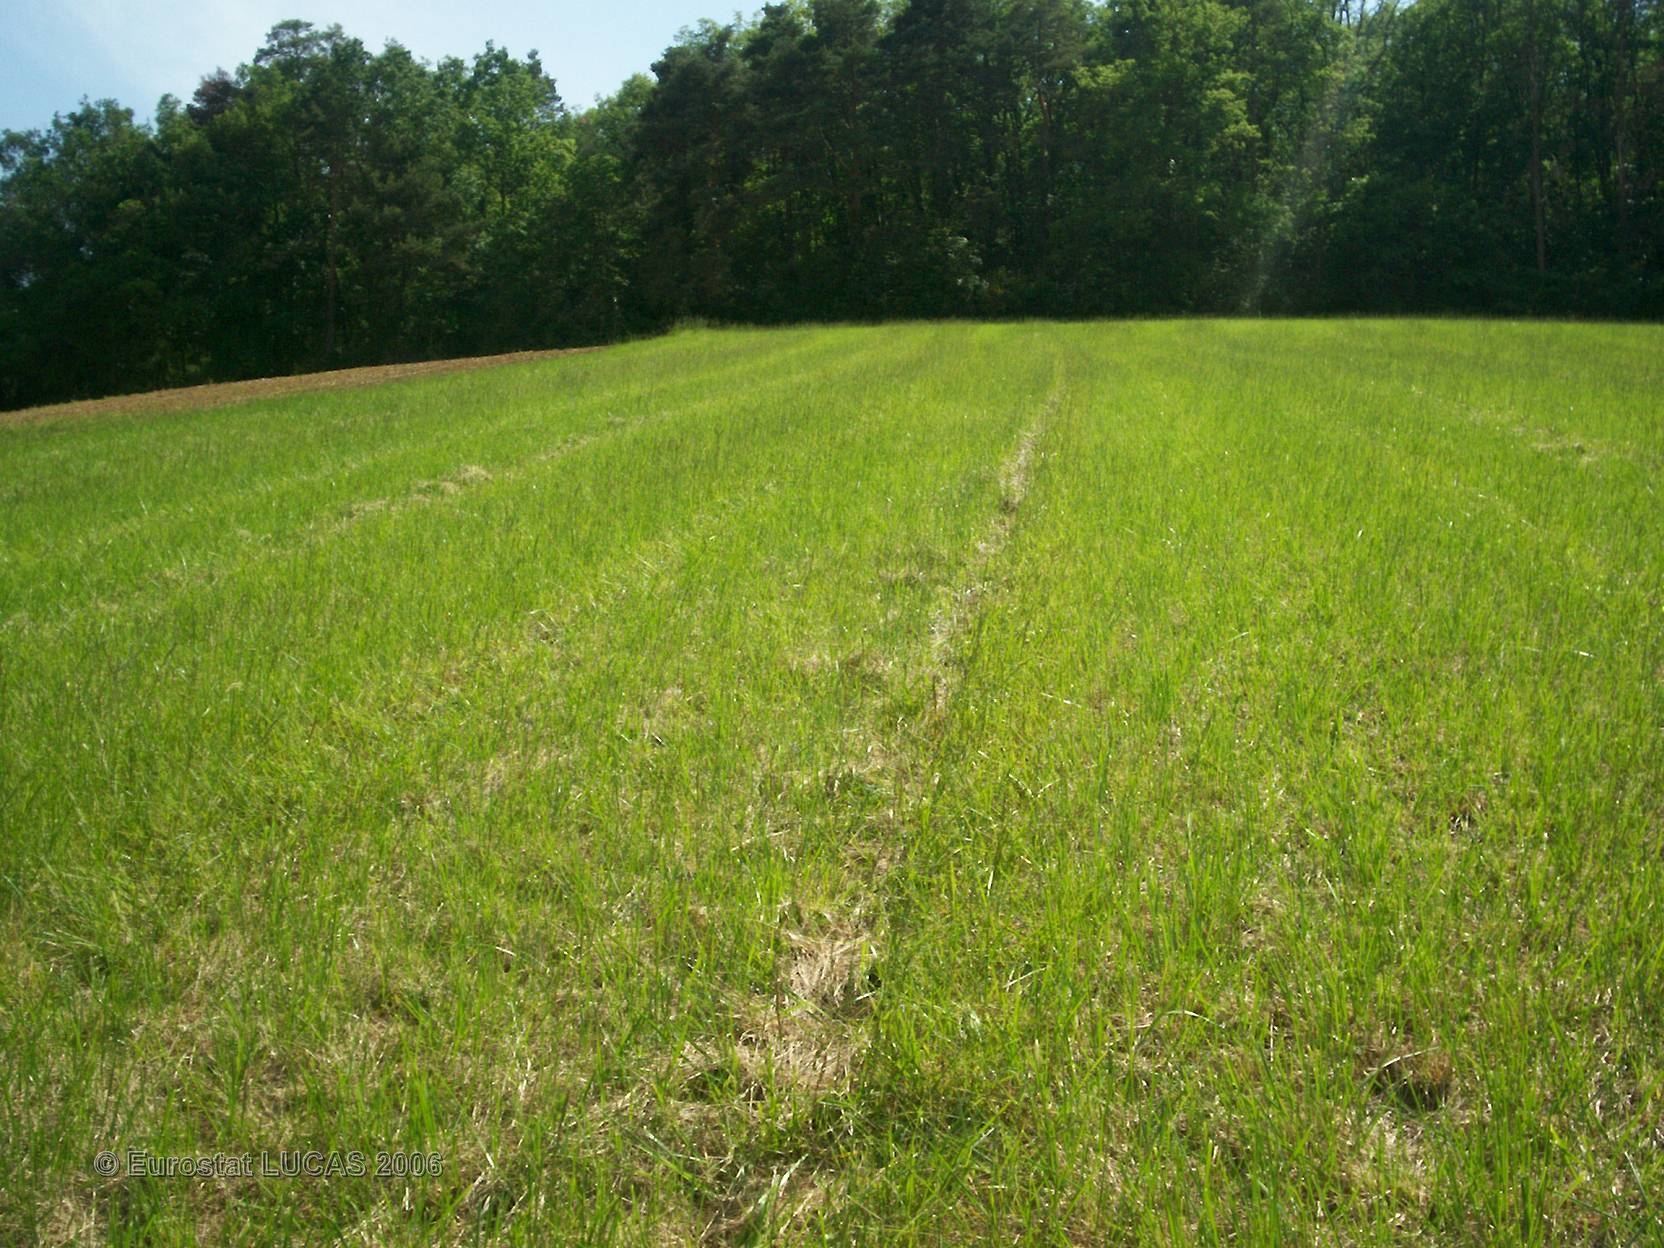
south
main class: Grassland
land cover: Grassland without tree/shrub cover
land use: Agriculture (excluding fallow land and kitchen gardens)
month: May
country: FR
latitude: 43.4415
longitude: 0.8947
